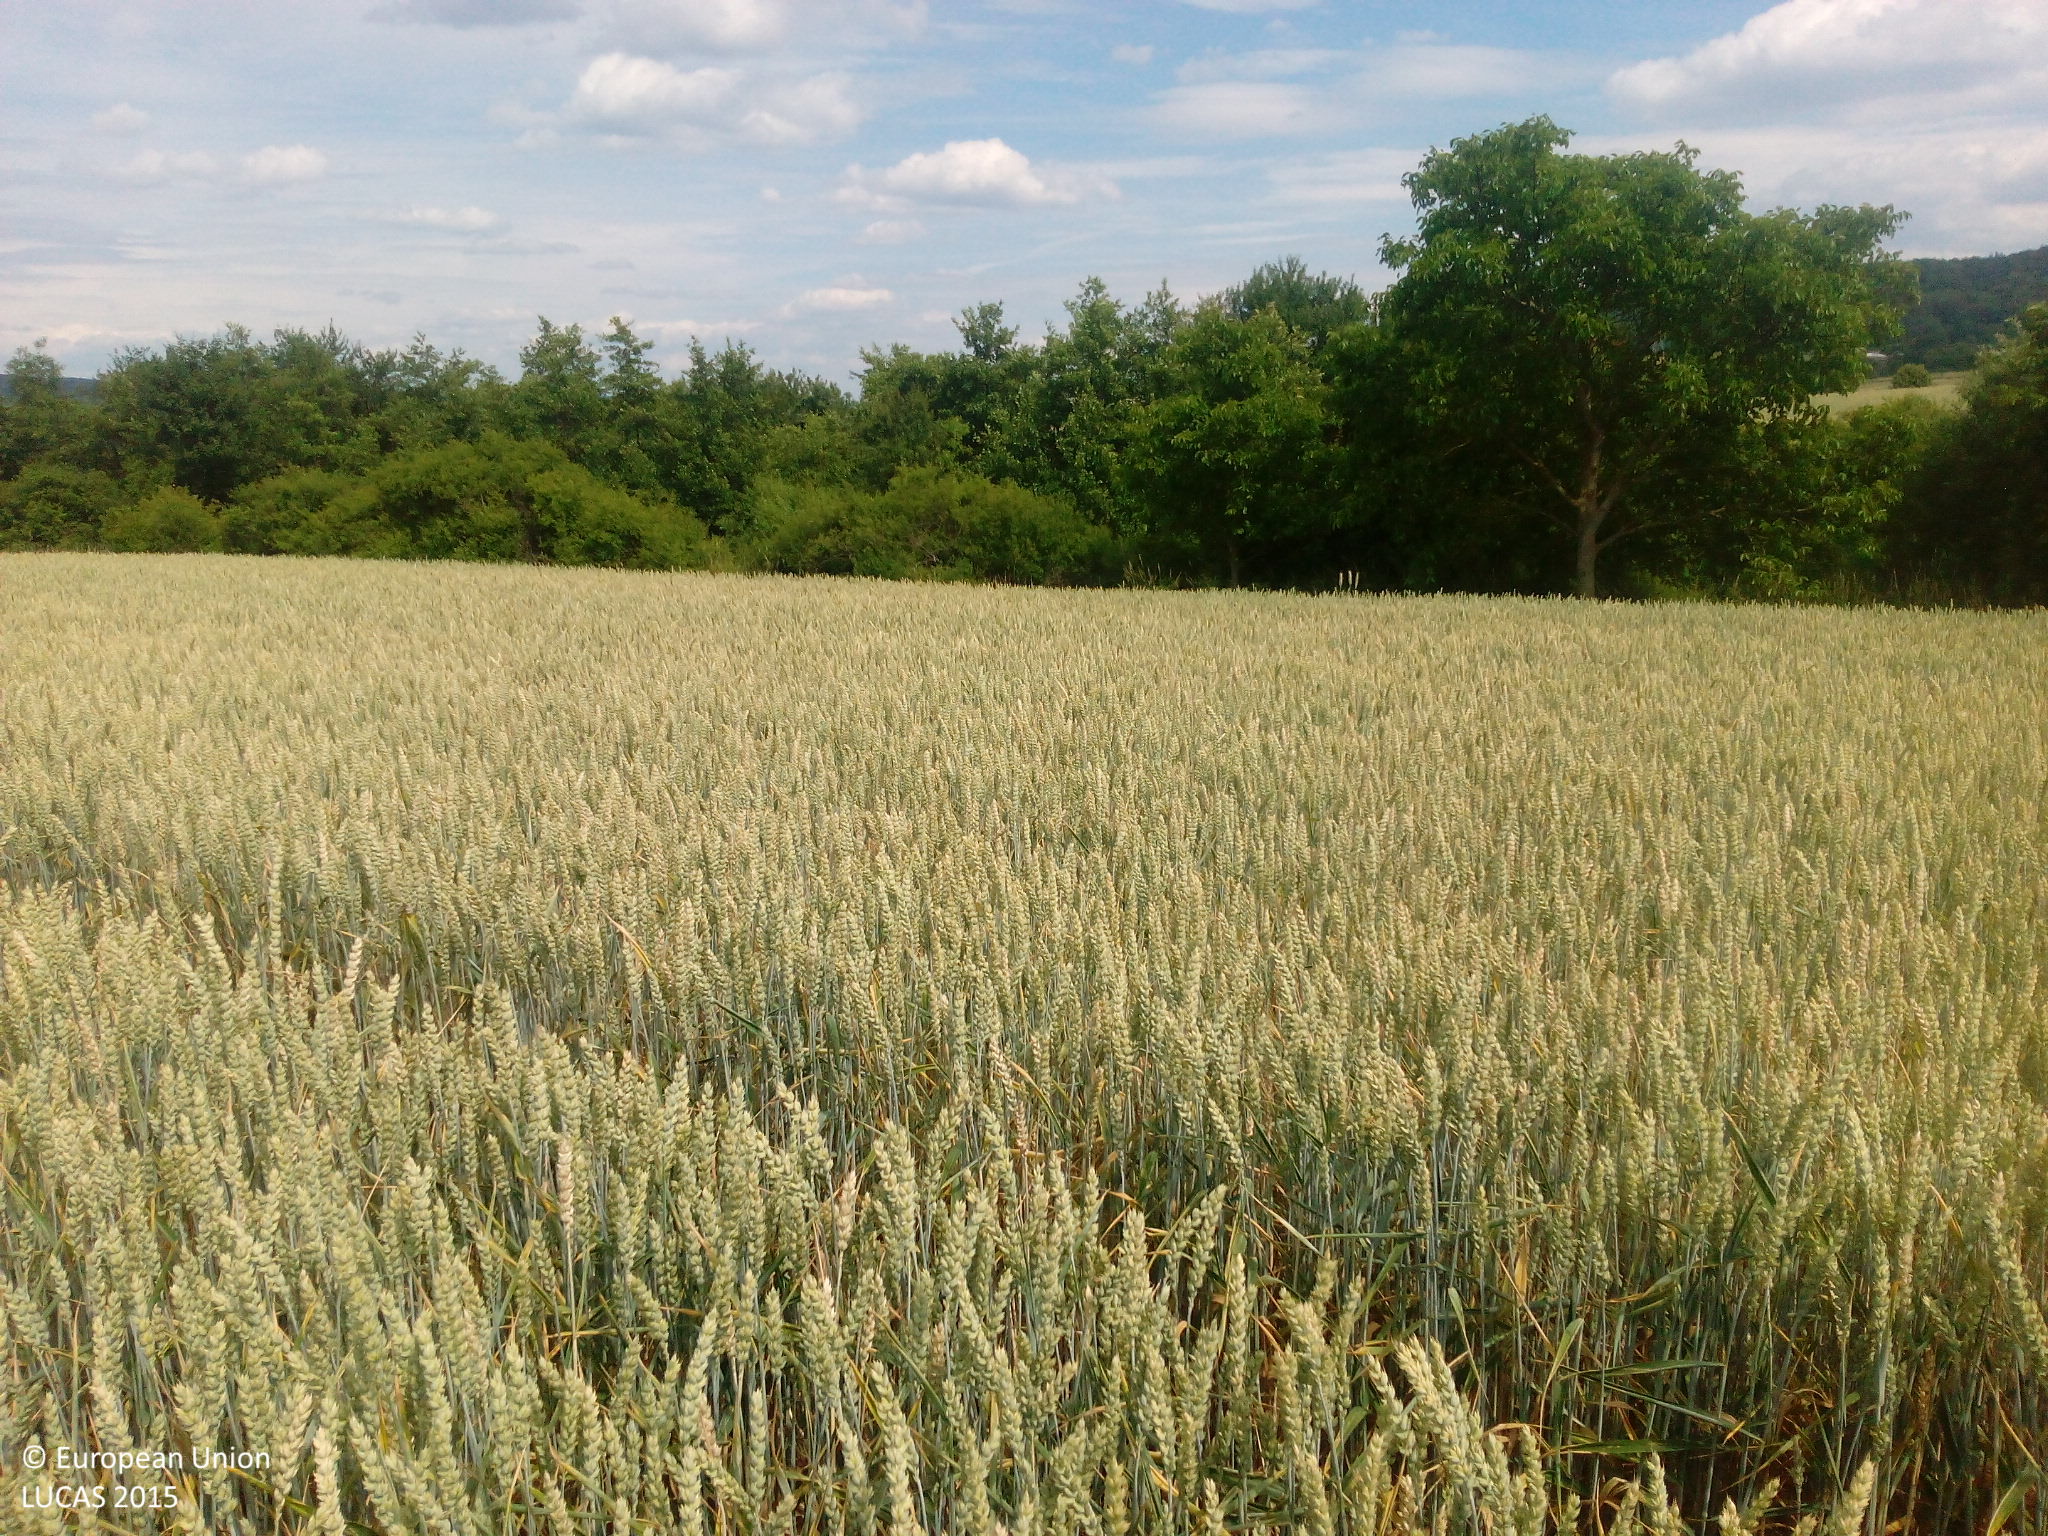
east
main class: Cropland
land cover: Common wheat
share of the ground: > 75 %
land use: Agriculture (excluding fallow land and kitchen gardens)
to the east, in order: Common wheat; Grass margins; Abandoned hedges; Grass margins; Tracks; Spontaneously vegetated surfaces; Rivers and streams; Broadleaved woodland; Grassland without tree/shrub cover; Common wheat
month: June
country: DE
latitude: 49.9850
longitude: 10.5716
